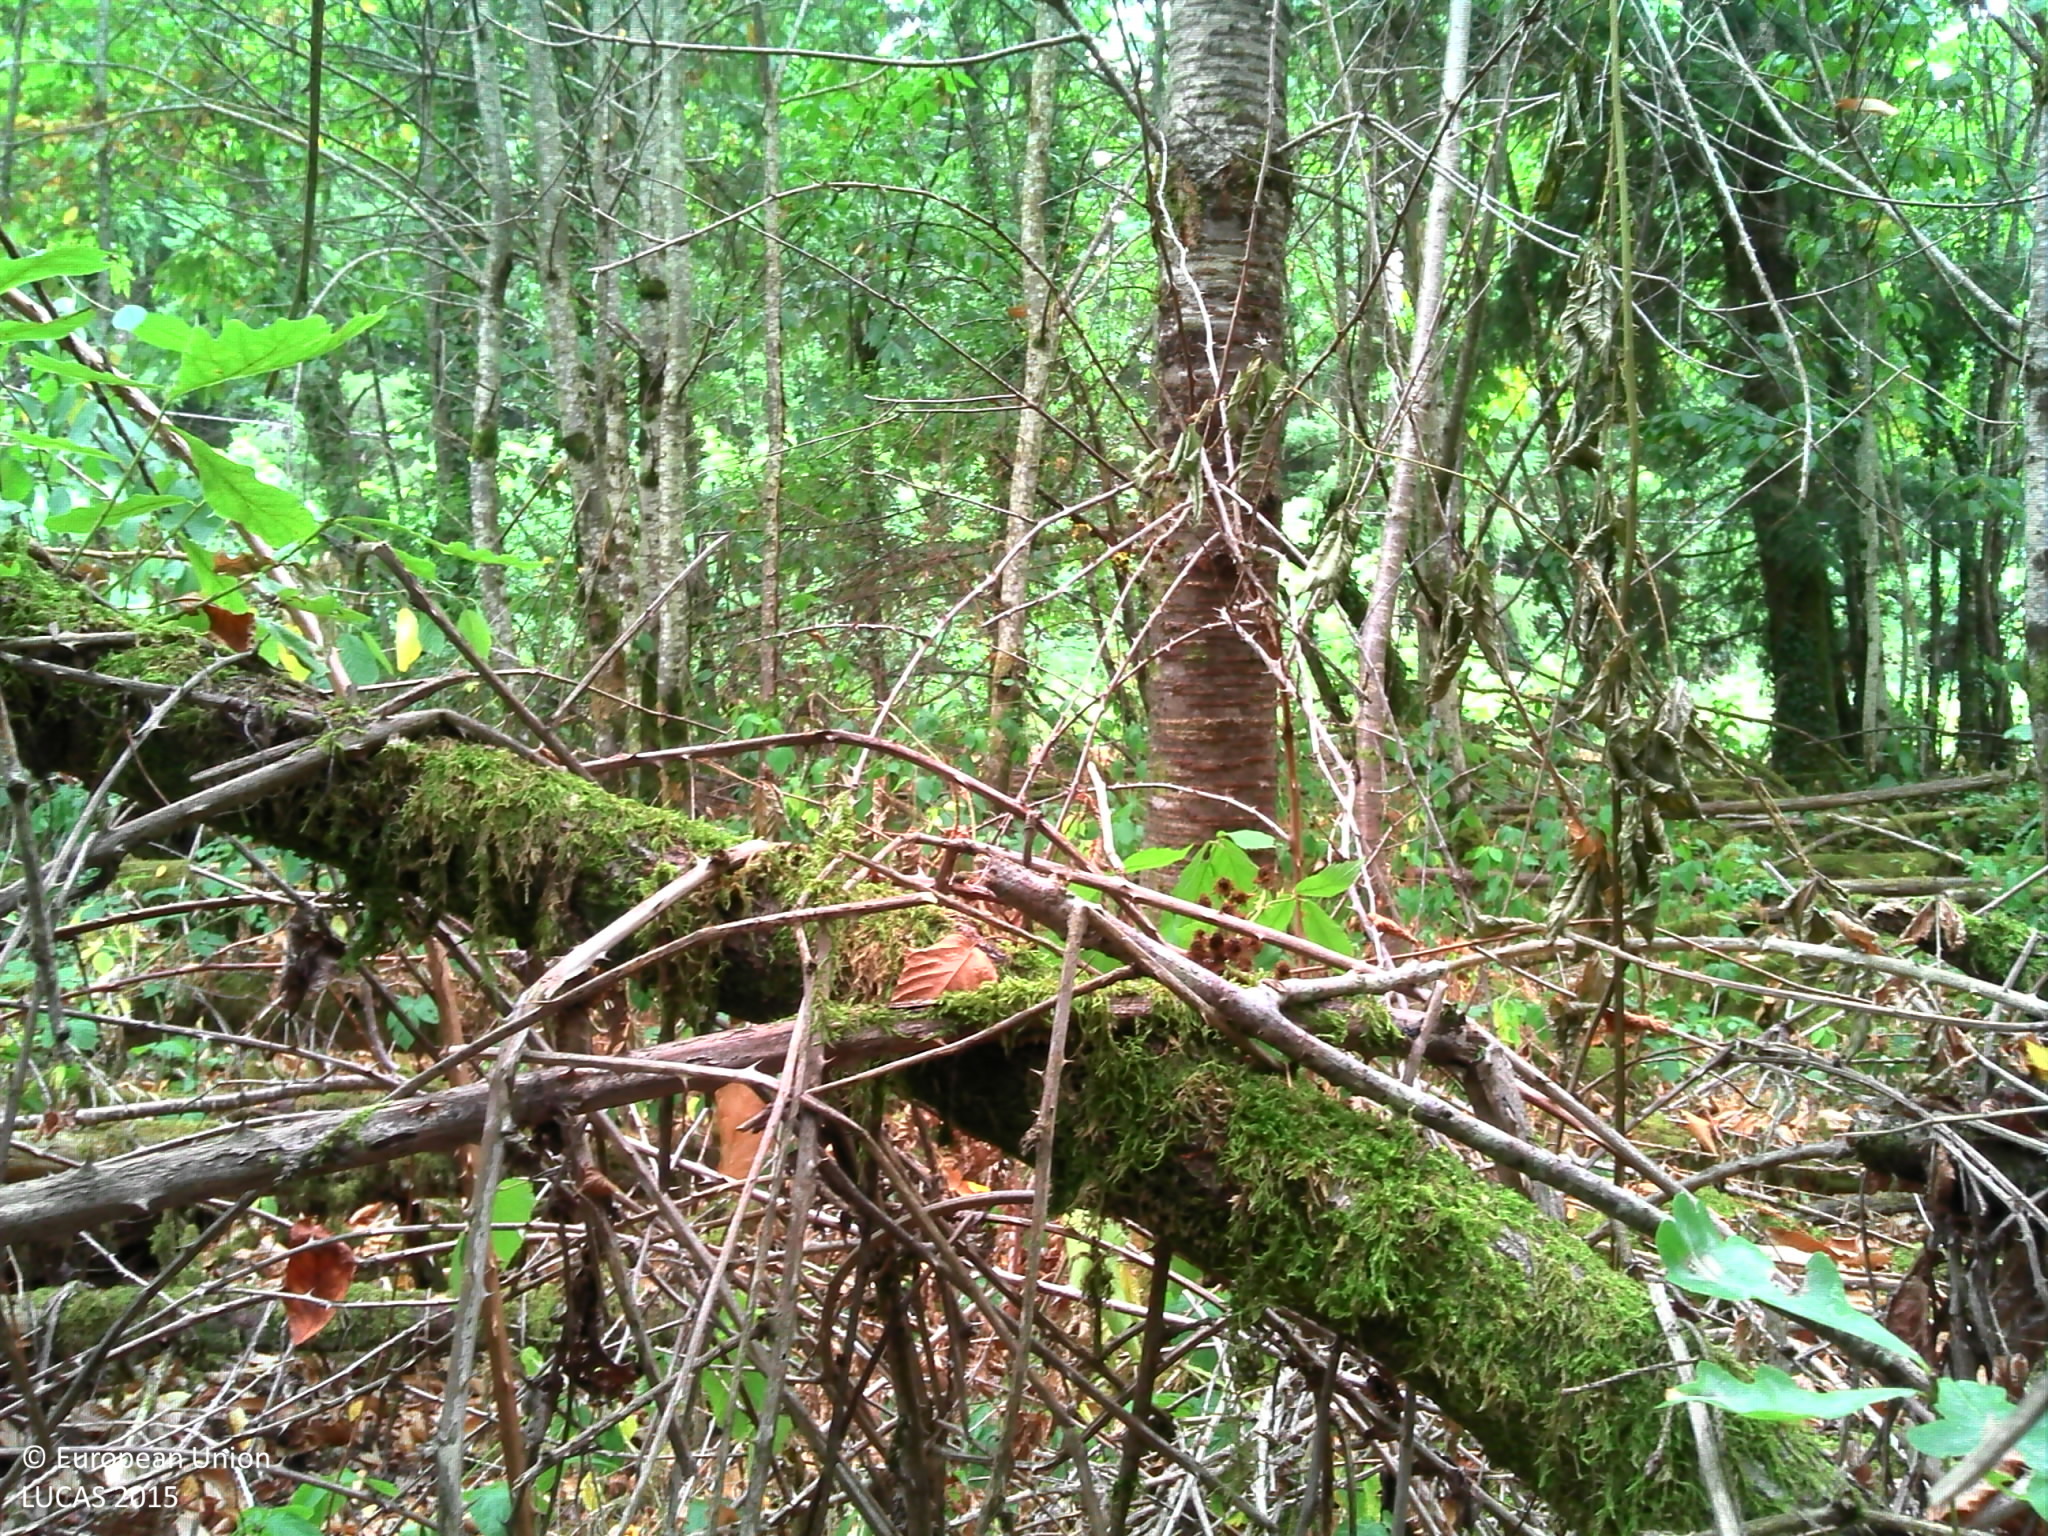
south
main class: Woodland
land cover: Broadleaved woodland
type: mesophytic deciduous forest
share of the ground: > 75 %
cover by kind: broadleaved forest trees 70 %, lichens and mosses 10 %, unconsolidated bare surface 10 %, coniferous forest trees 5 %, herbaceous plants 5 %
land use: Forestry
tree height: > 5 m
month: July
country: FR
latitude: 45.5957
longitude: 0.6423
